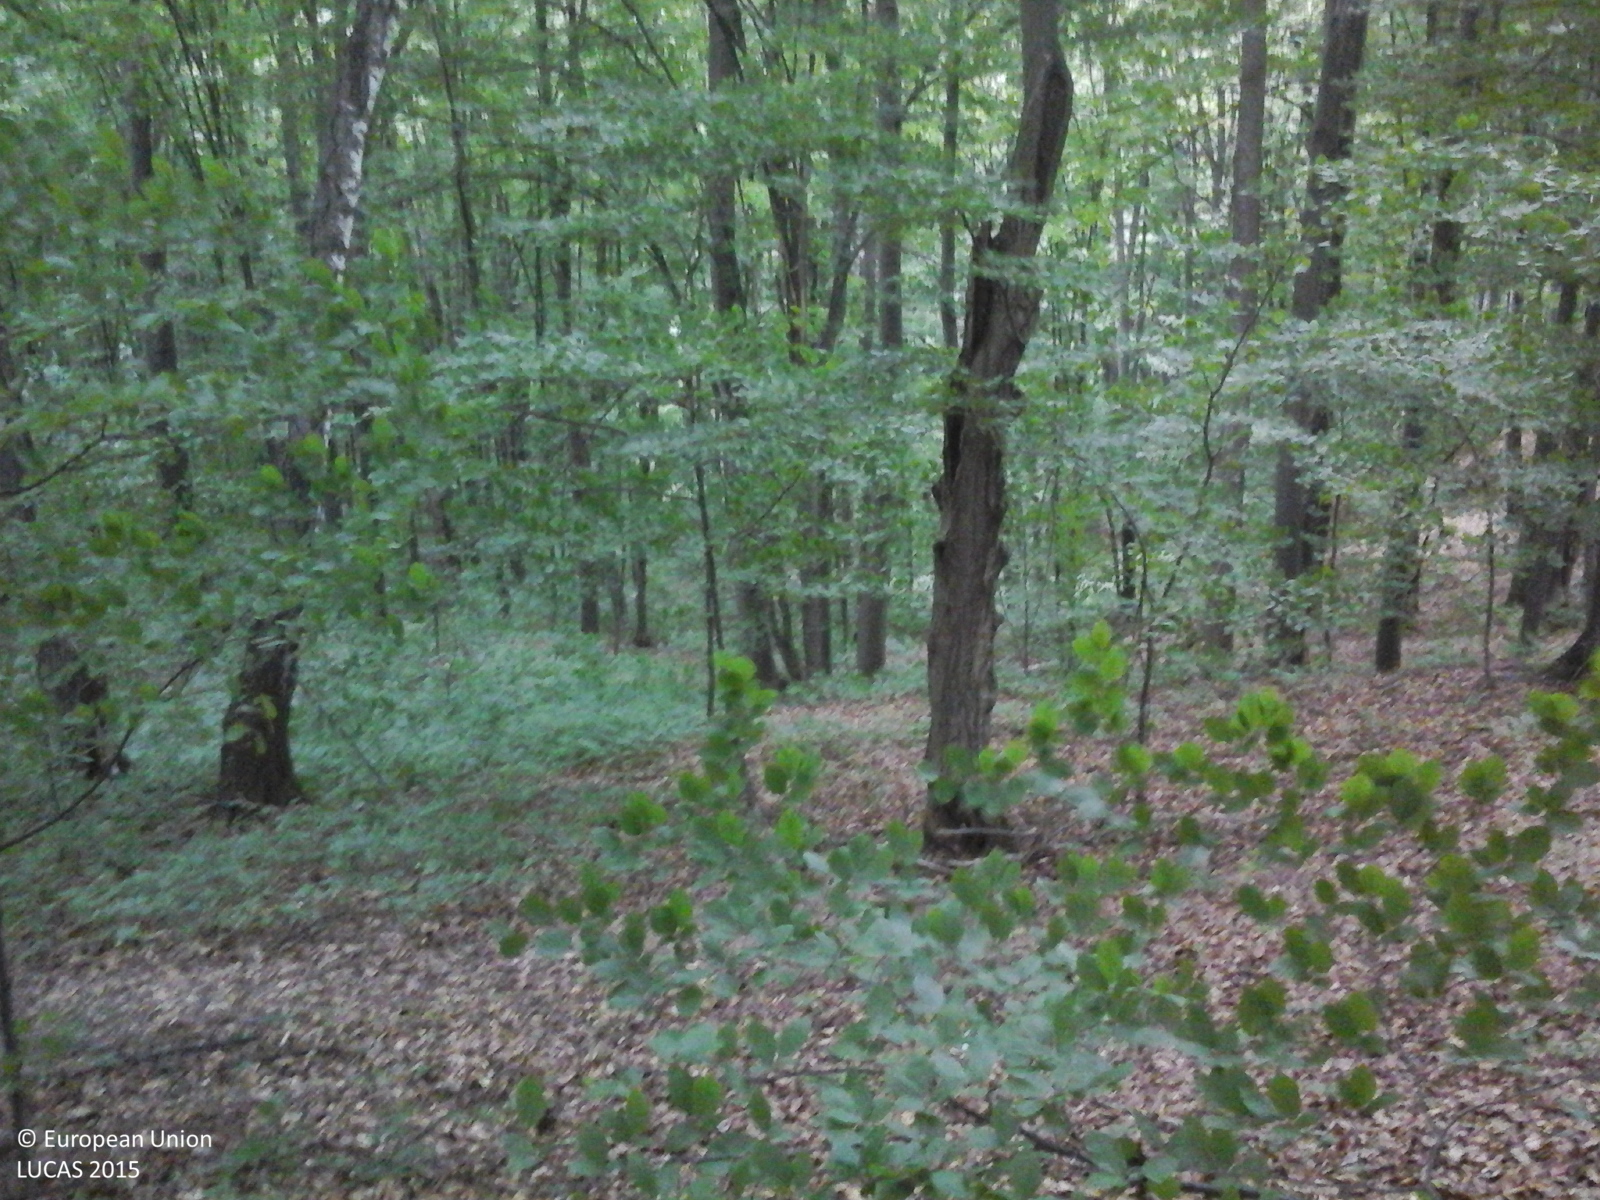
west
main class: Woodland
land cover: Broadleaved woodland
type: beech forest
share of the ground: > 75 %
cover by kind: broadleaved forest trees 100 %
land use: Forestry
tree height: > 5 m
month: June
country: RO
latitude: 46.6161
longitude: 26.5236
